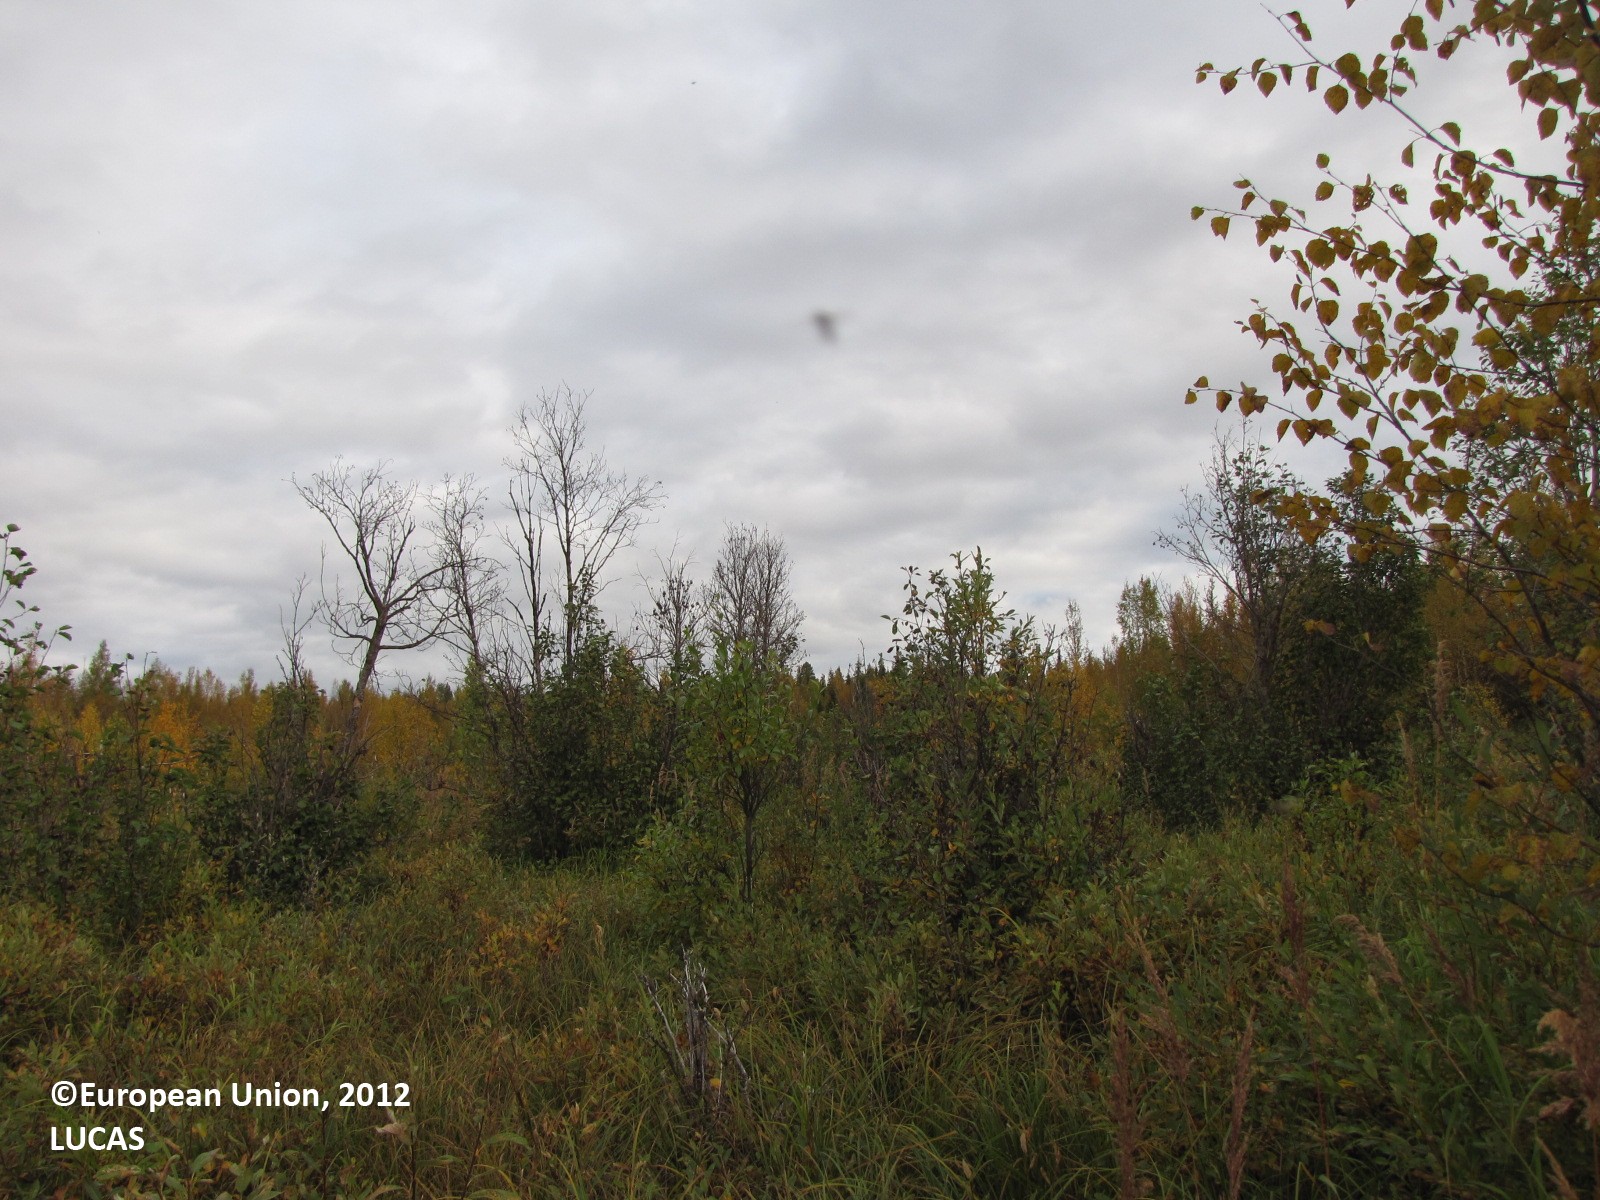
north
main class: Woodland
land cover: Broadleaved woodland
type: boreal forest
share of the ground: 10 - 25 %
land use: Forestry
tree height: > 5 m
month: September
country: FI
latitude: 67.1983
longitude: 23.5945
